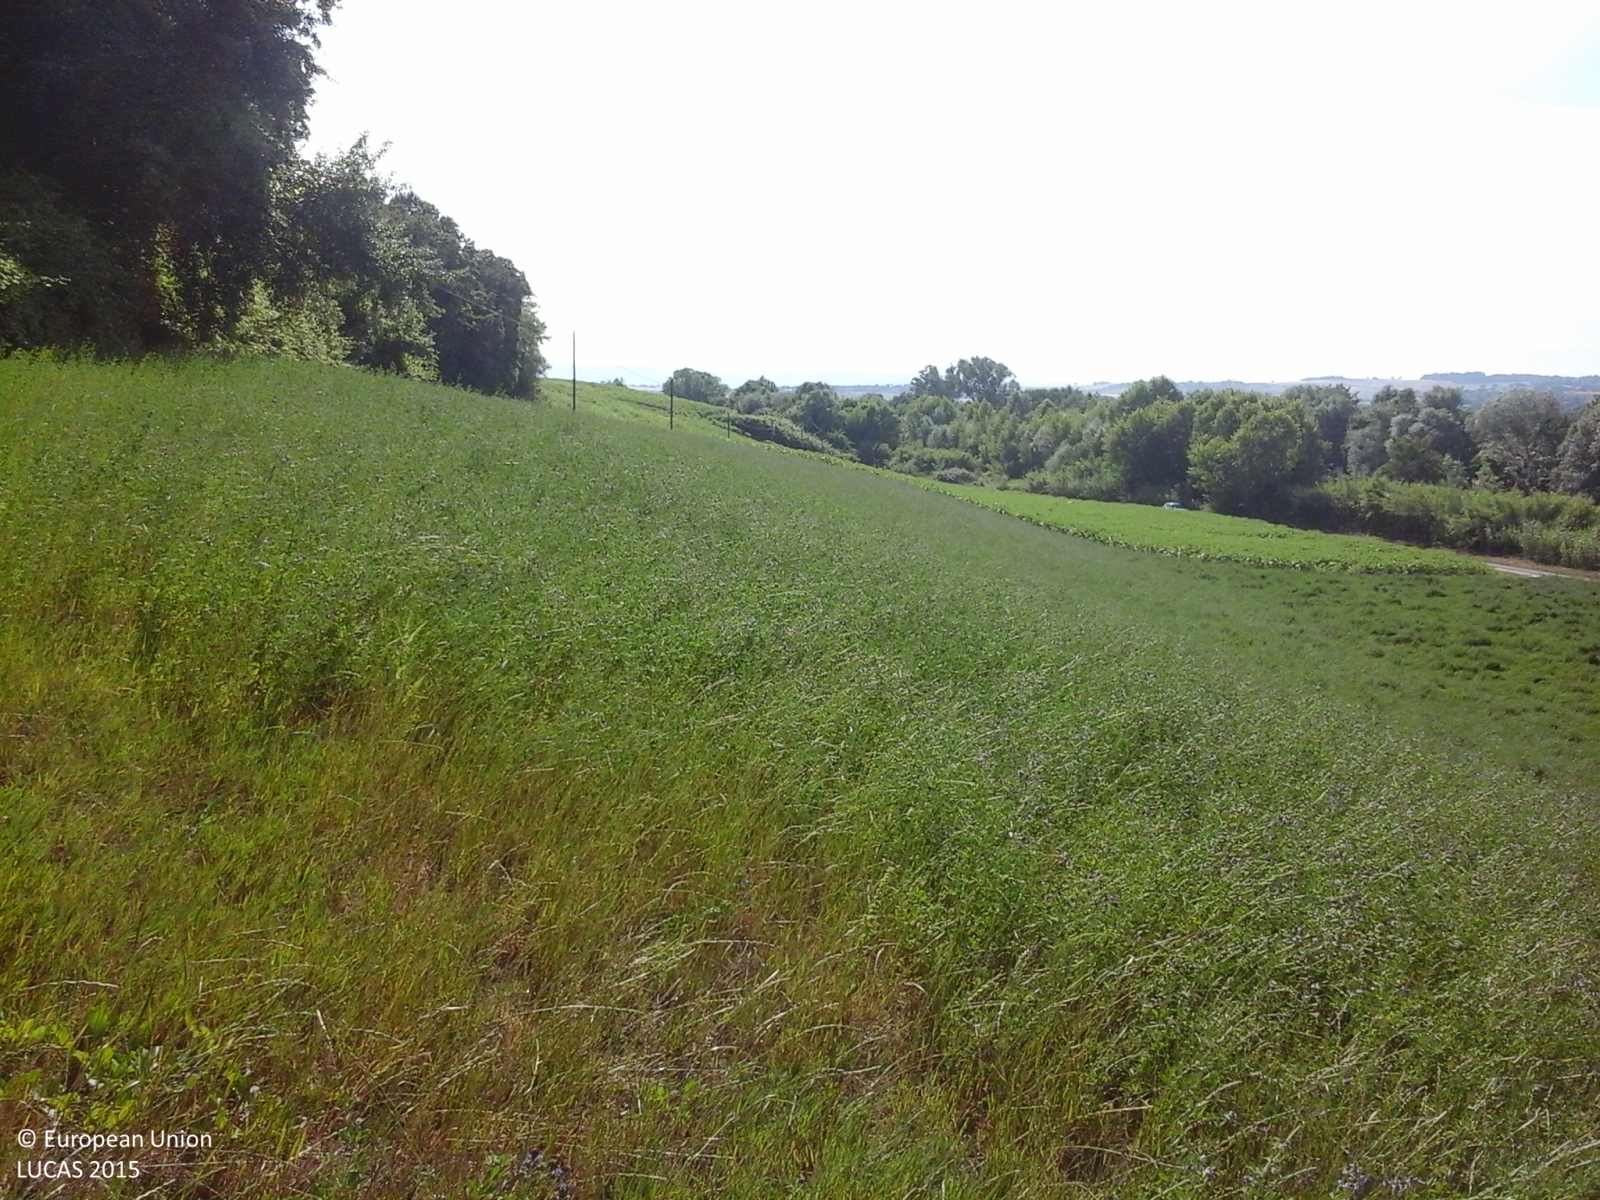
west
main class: Woodland
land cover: Broadleaved woodland
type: thermophilous deciduous forest
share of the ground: > 75 %
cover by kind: broadleaved forest trees 90 %, shrubs 5 %, herbaceous plants 5 %
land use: Forestry
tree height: > 5 m
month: June
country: IT
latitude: 43.3359
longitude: 13.4571
